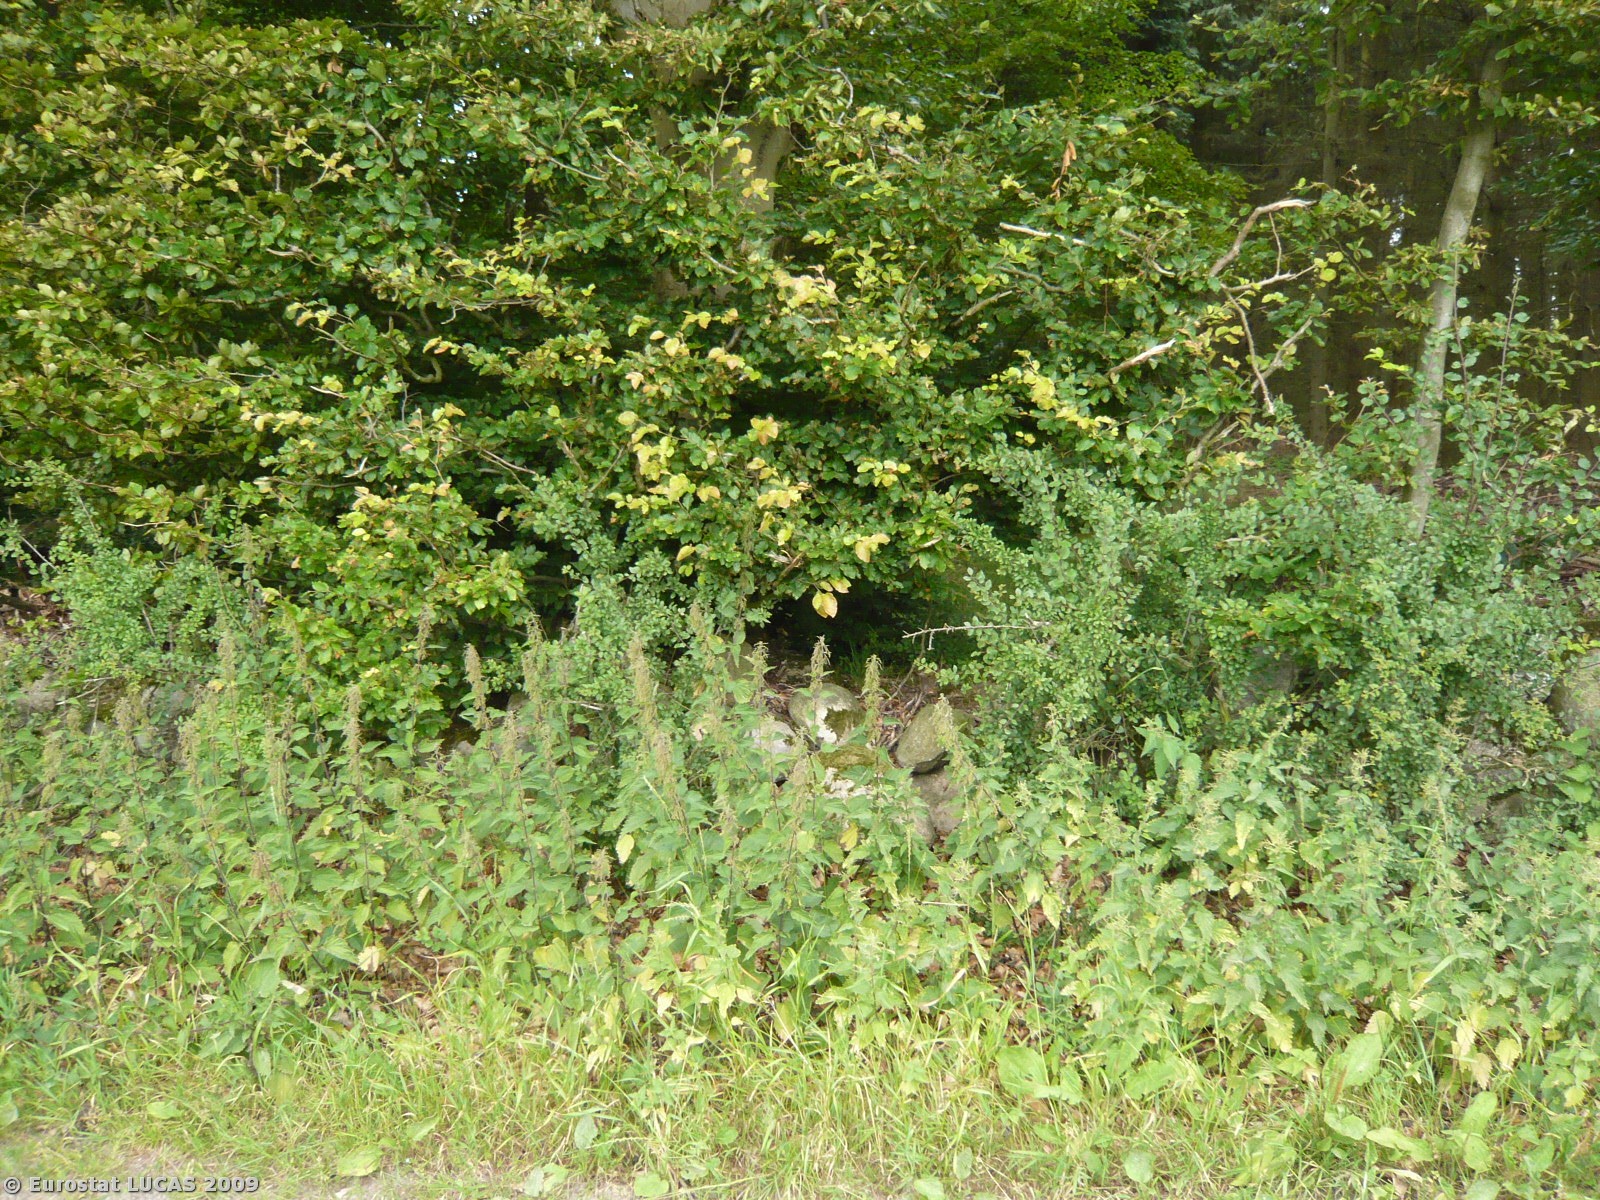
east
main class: Cropland
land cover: Common wheat
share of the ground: > 75 %
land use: Agriculture (excluding fallow land and kitchen gardens)
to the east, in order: Common wheat; Tracks; Broadleaved woodland; Dry stone walls; Coniferous woodland; Spontaneously vegetated surfaces
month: July
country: DK
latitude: 55.5293
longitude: 11.6937
